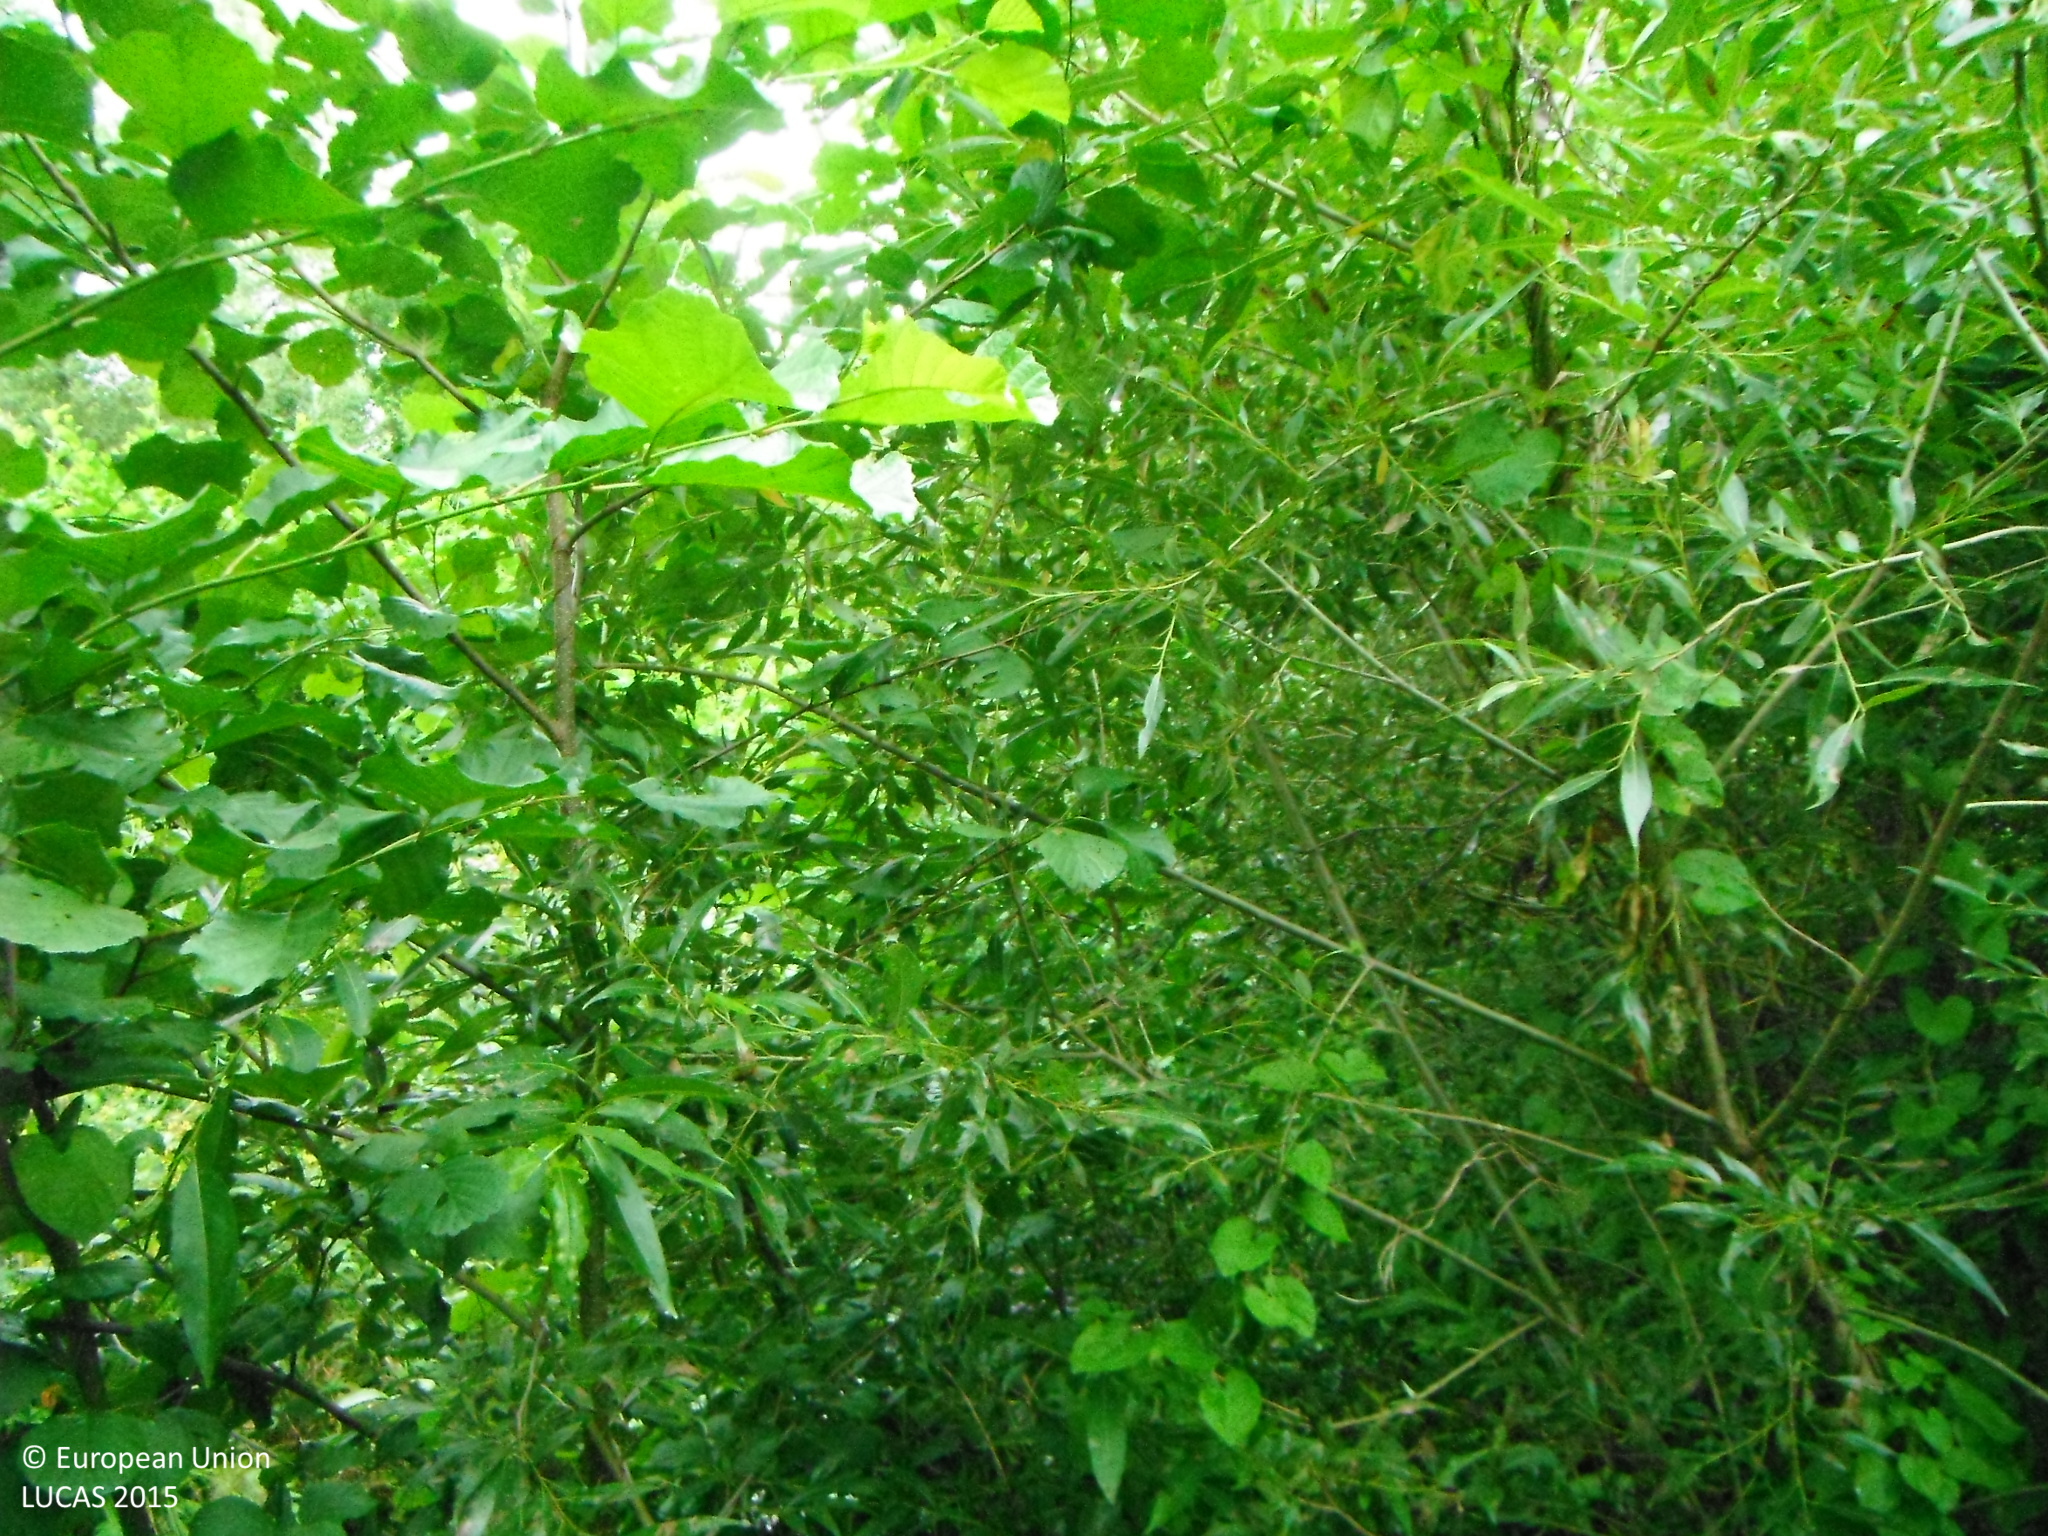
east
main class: Woodland
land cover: Broadleaved woodland
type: floodplain forest
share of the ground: > 75 %
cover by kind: broadleaved forest trees 80 %, shrubs 20 %
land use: Forestry
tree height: > 5 m
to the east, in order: Broadleaved woodland; Rivers and streams; Broadleaved woodland; Shrubland without tree cover; Broadleaved woodland; Rivers and streams; Shrubland without tree cover; Grassland with sparse tree/shrub cover; Fences; Grassland with sparse tree/shrub cover; Electric lines; Fences; Grassland with sparse tree/shrub cover; Shrubland without tree cover; Grass margins; Paved roads, cycling and walking lanes; Shrubland with sparse tree cover; Grassland without tree/shrub cover
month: July
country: SK
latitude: 48.3755
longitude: 19.0526
